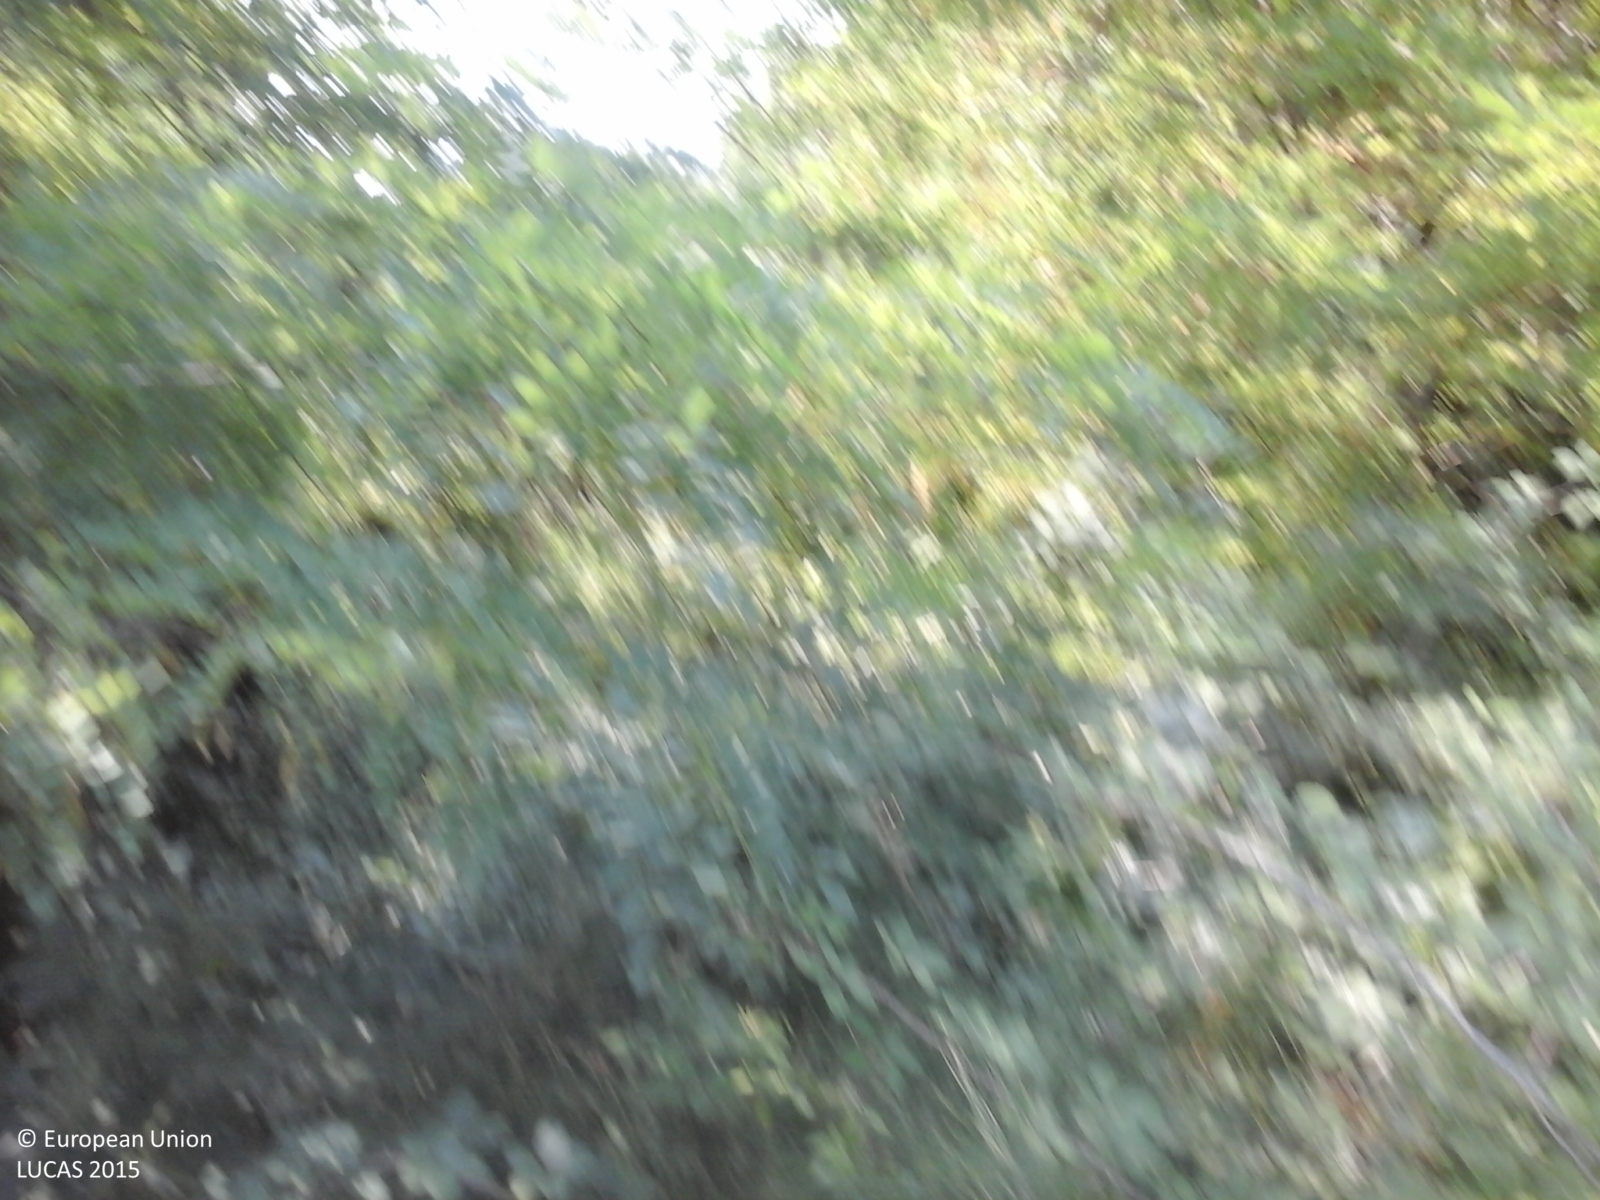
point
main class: Woodland
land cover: Broadleaved woodland
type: thermophilous deciduous forest
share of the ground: > 75 %
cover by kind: broadleaved forest trees 100 %
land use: Forestry
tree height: > 5 m
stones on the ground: < 10 %
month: August
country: IT
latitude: 43.8526
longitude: 12.4448
